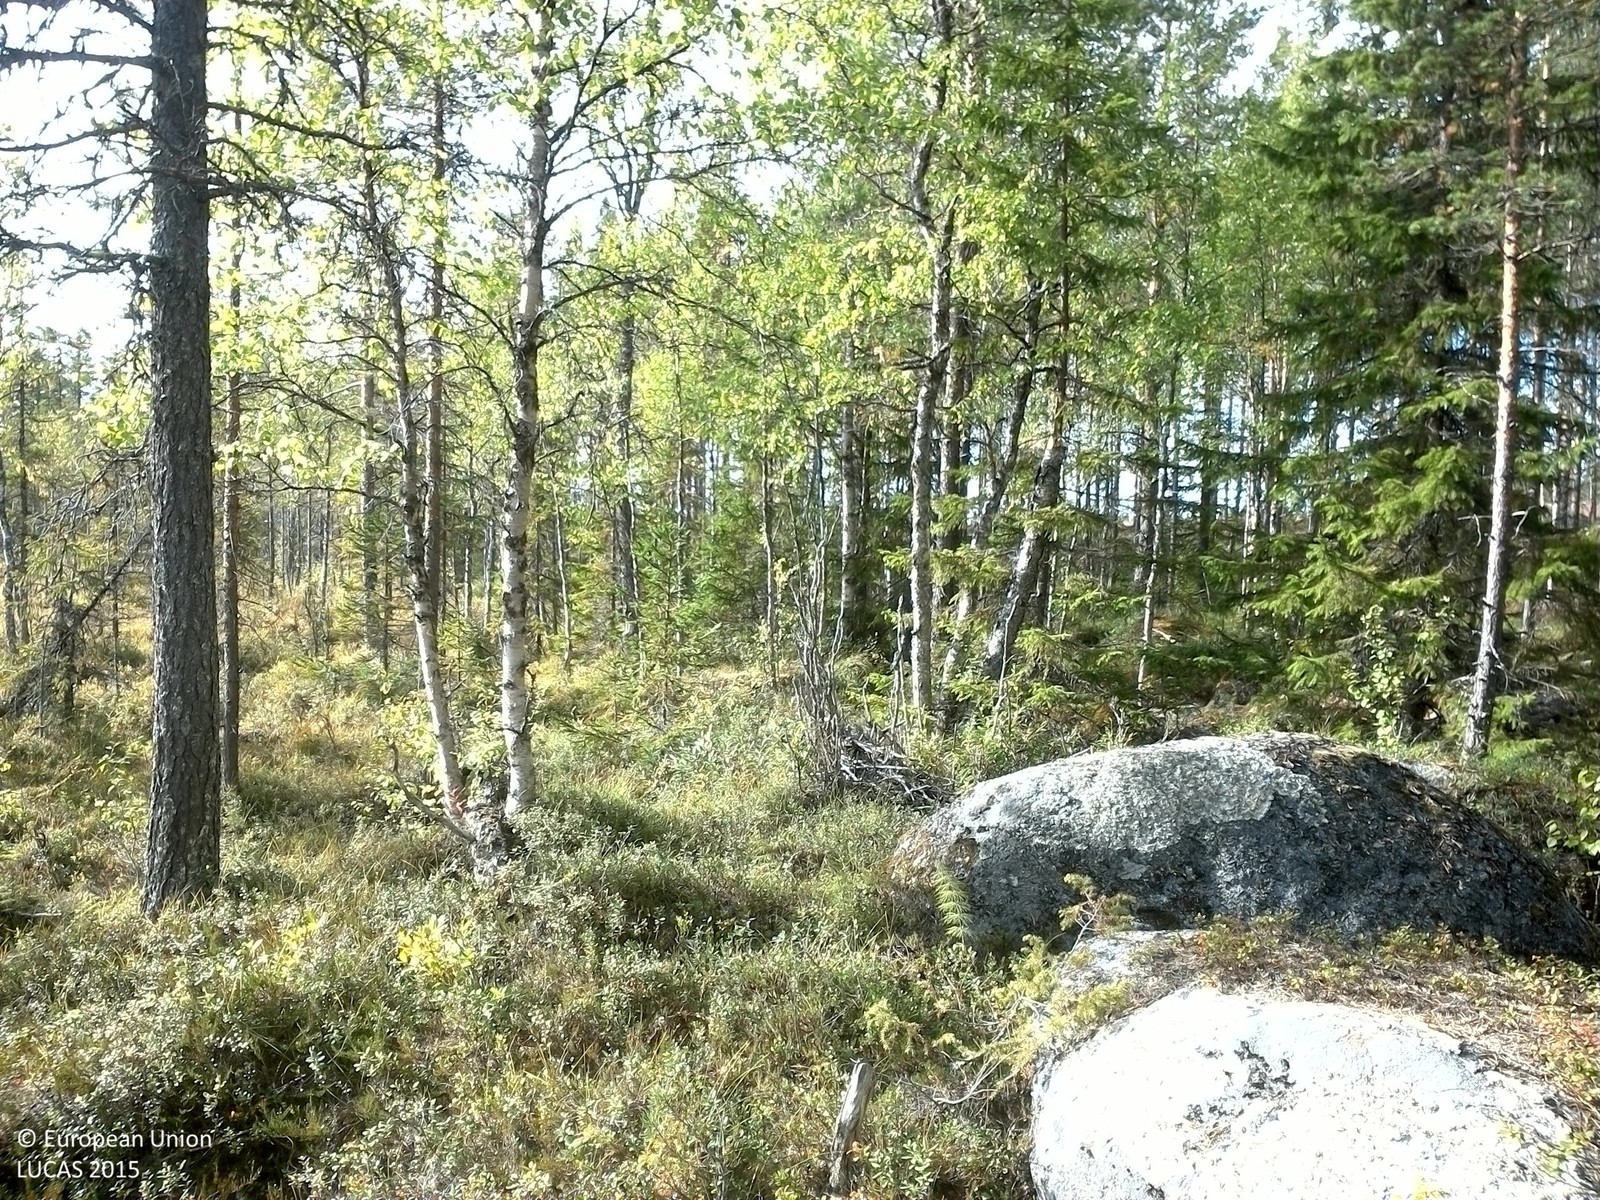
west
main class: Woodland
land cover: Pine dominated coniferous woodland
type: boreal forest
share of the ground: 50 - 75 %
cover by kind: coniferous forest trees 50 %, shrubs 35 %, broadleaved forest trees 10 %, lichens and mosses 5 %
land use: Forestry
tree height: > 5 m
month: September
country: SE
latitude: 64.1853
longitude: 17.4819
